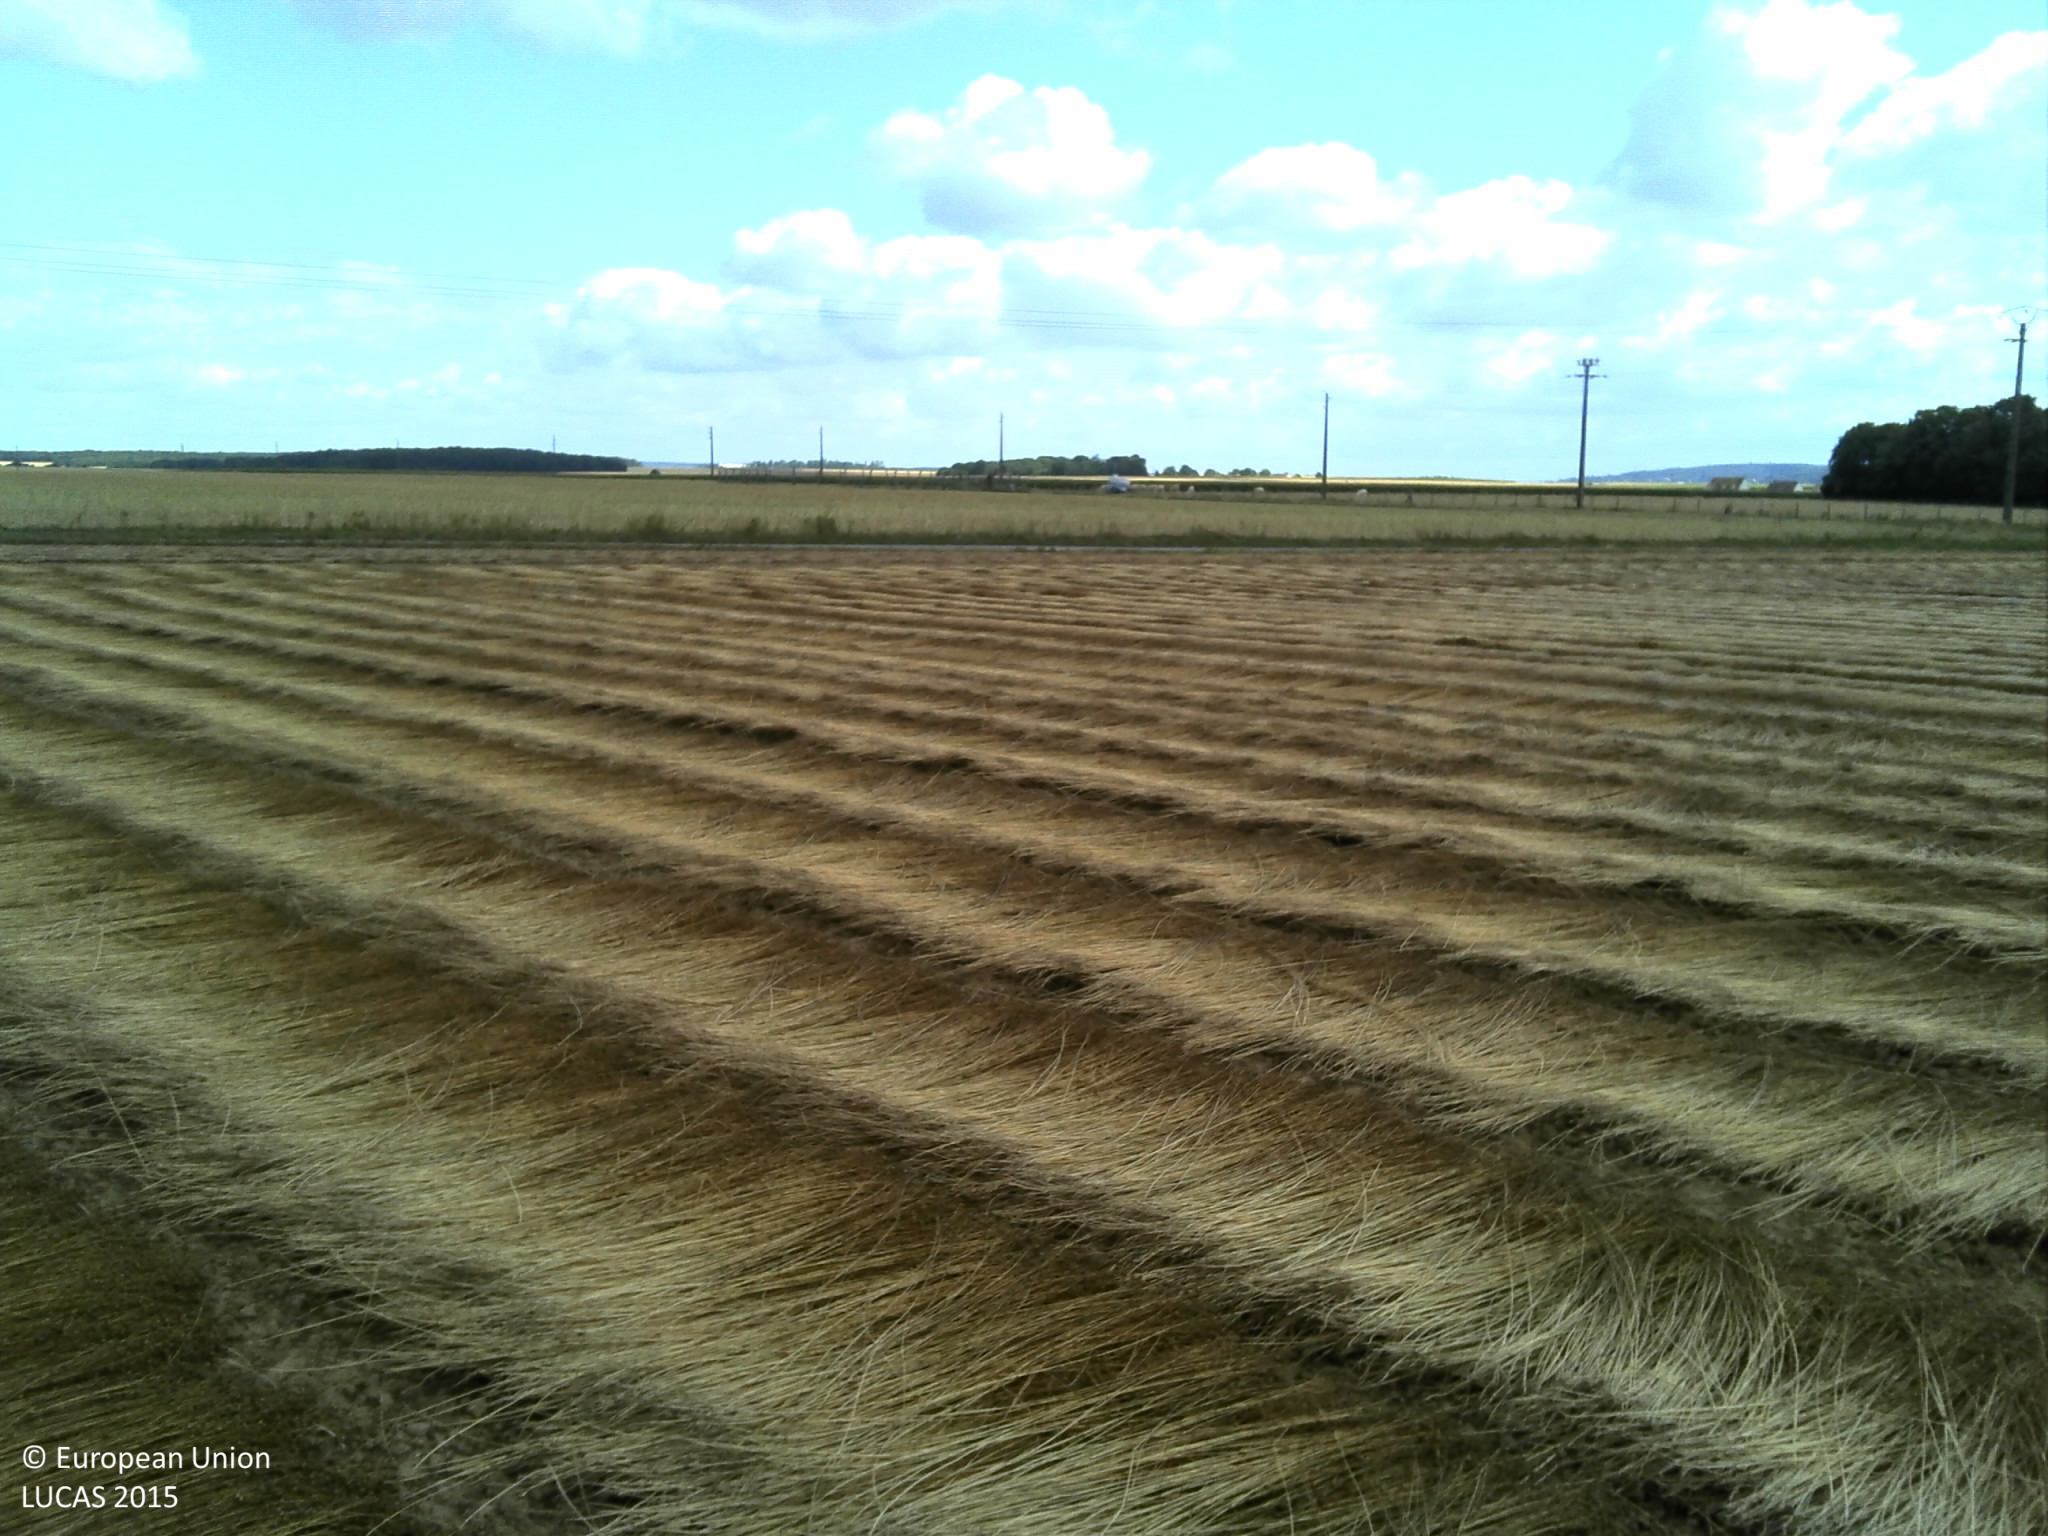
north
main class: Cropland
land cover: Other fibre and oleaginous crops
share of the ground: > 75 %
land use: Agriculture (excluding fallow land and kitchen gardens)
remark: Harvested field
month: July
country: FR
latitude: 48.8774
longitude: 1.8170
